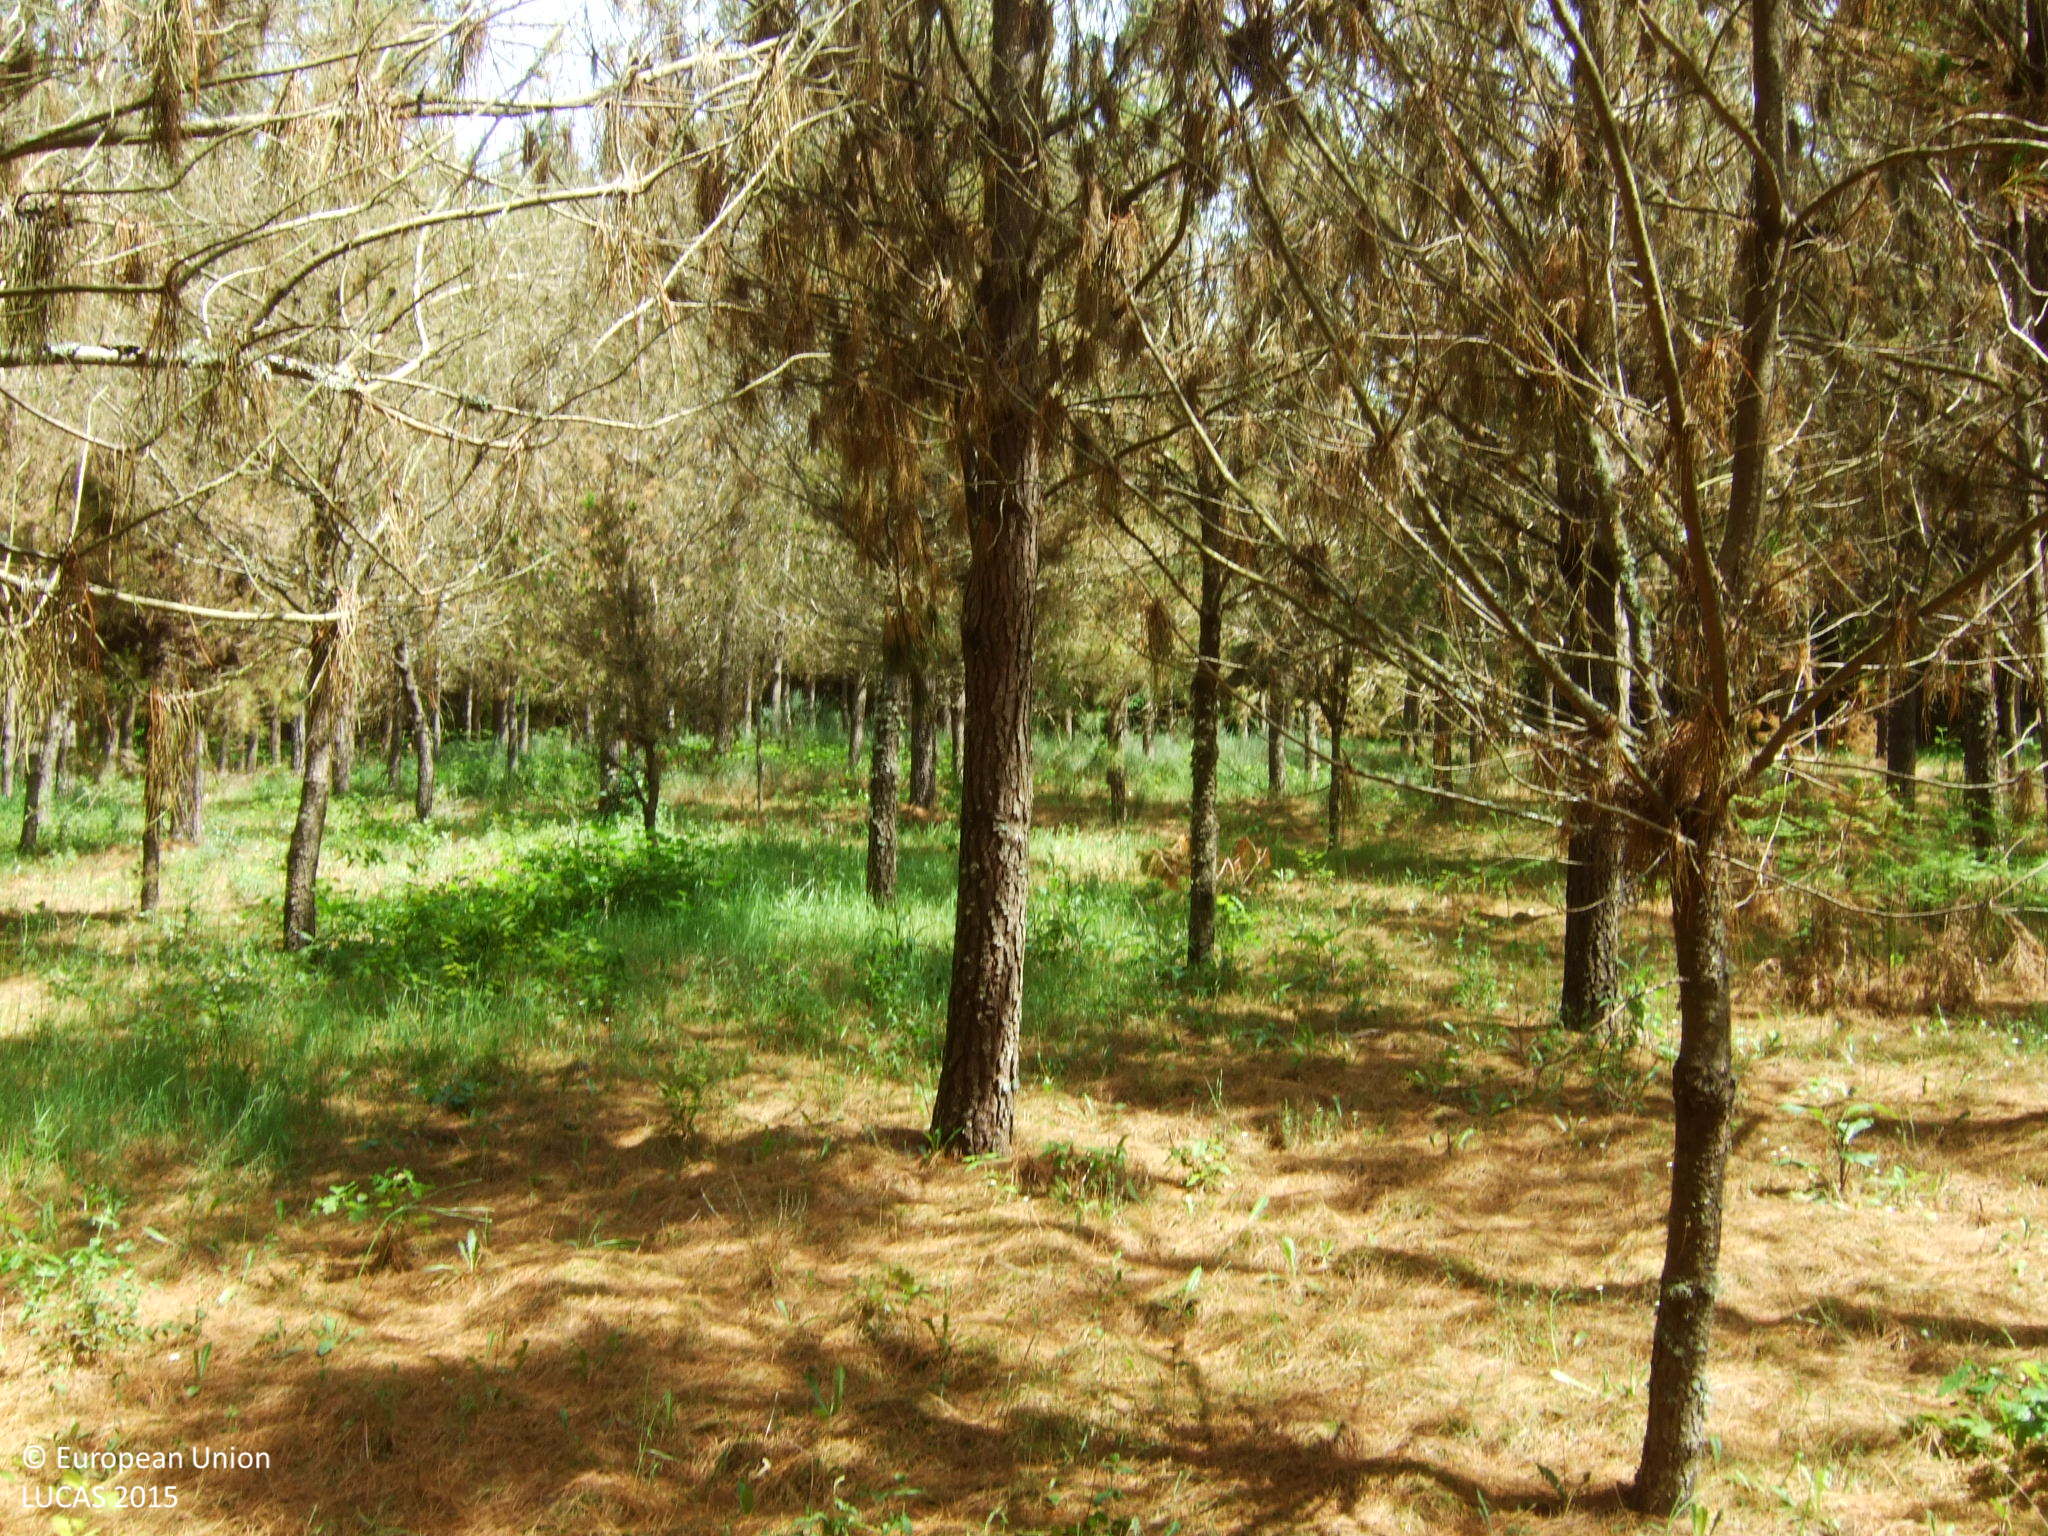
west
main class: Woodland
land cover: Pine dominated coniferous woodland
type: exotic forest
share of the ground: 50 - 75 %
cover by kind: coniferous forest trees 65 %, unconsolidated bare surface 25 %, shrubs 10 %
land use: Forestry
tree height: > 5 m
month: May
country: ES
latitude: 42.8723
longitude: -7.3674
